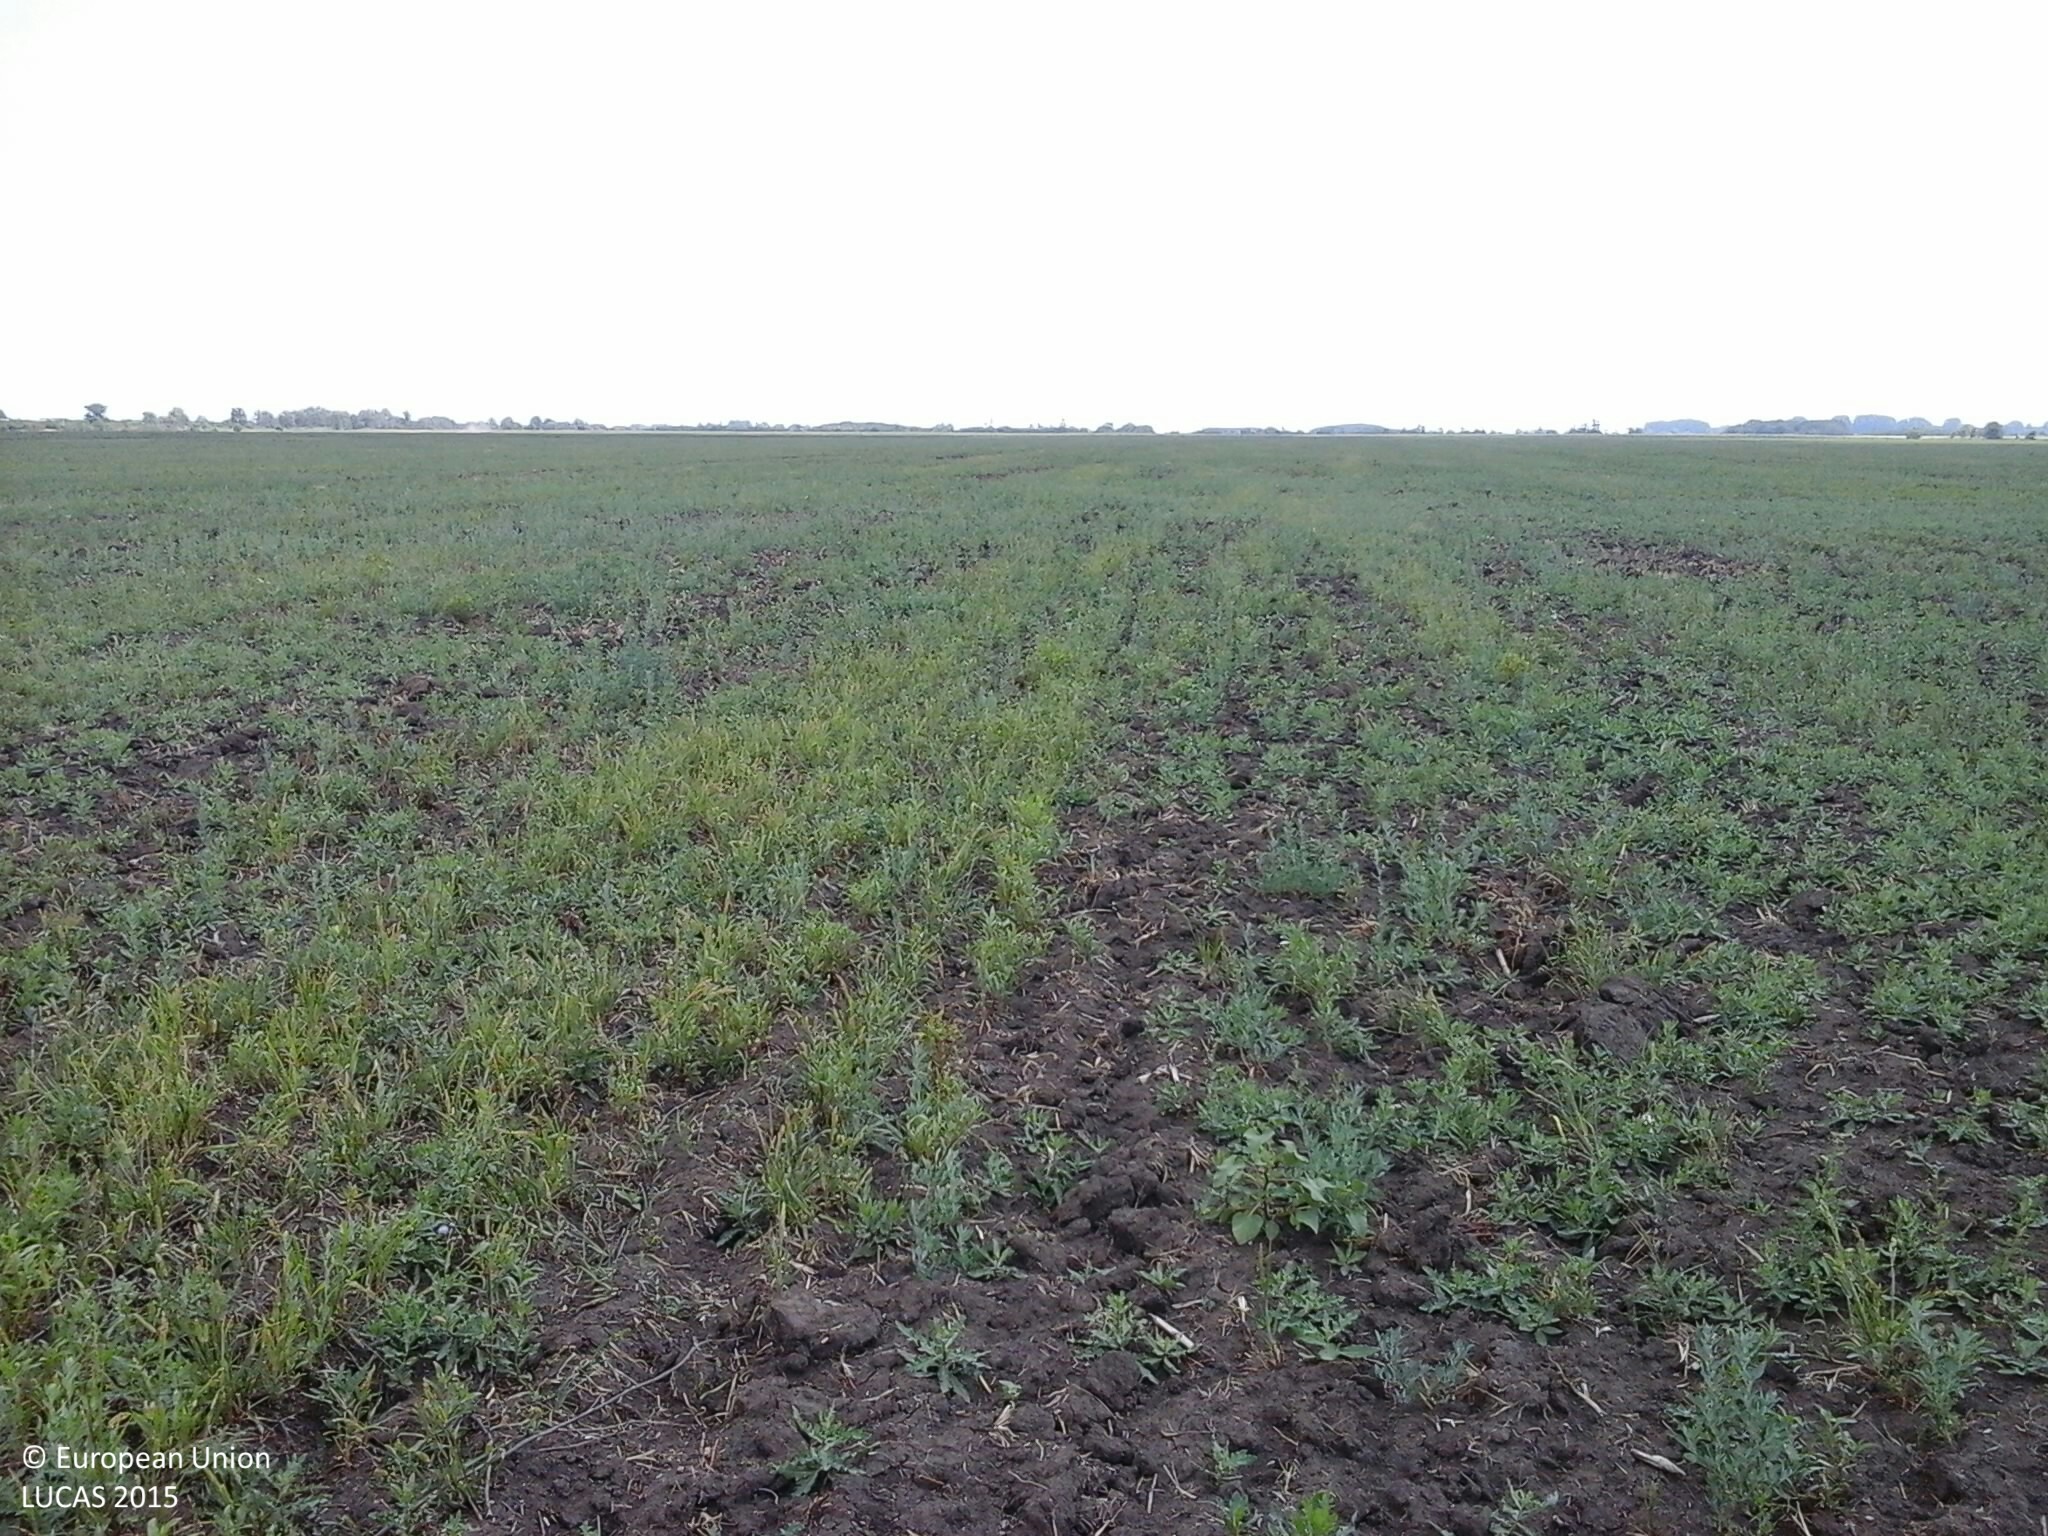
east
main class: Grassland
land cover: Spontaneously vegetated surfaces
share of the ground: 50 - 75 %
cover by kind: herbaceous plants 60 %, unconsolidated bare surface 40 %
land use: Fallow land
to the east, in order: Spontaneously vegetated surfaces
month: August
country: HU
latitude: 47.6030
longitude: 20.9569
